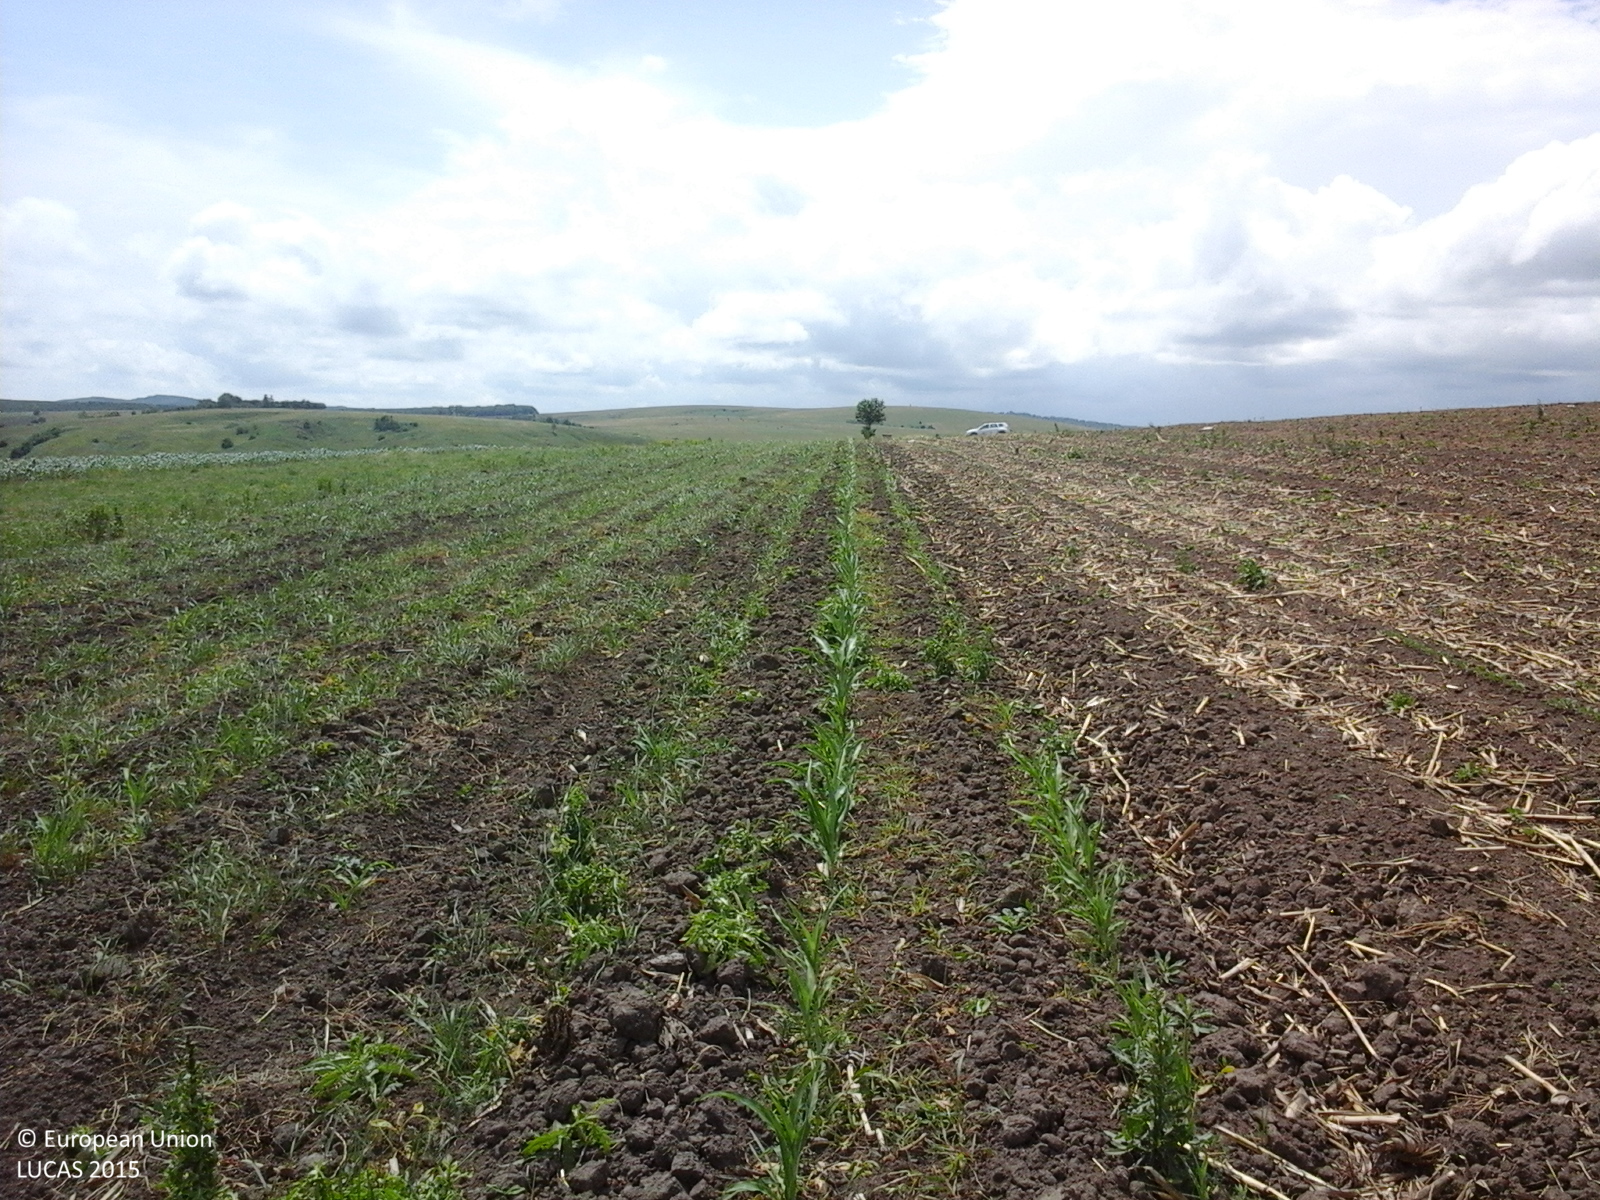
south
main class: Cropland
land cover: Maize
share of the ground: 25 - 50 %
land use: Agriculture (excluding fallow land and kitchen gardens)
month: May
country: RO
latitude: 47.1459
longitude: 26.4231
